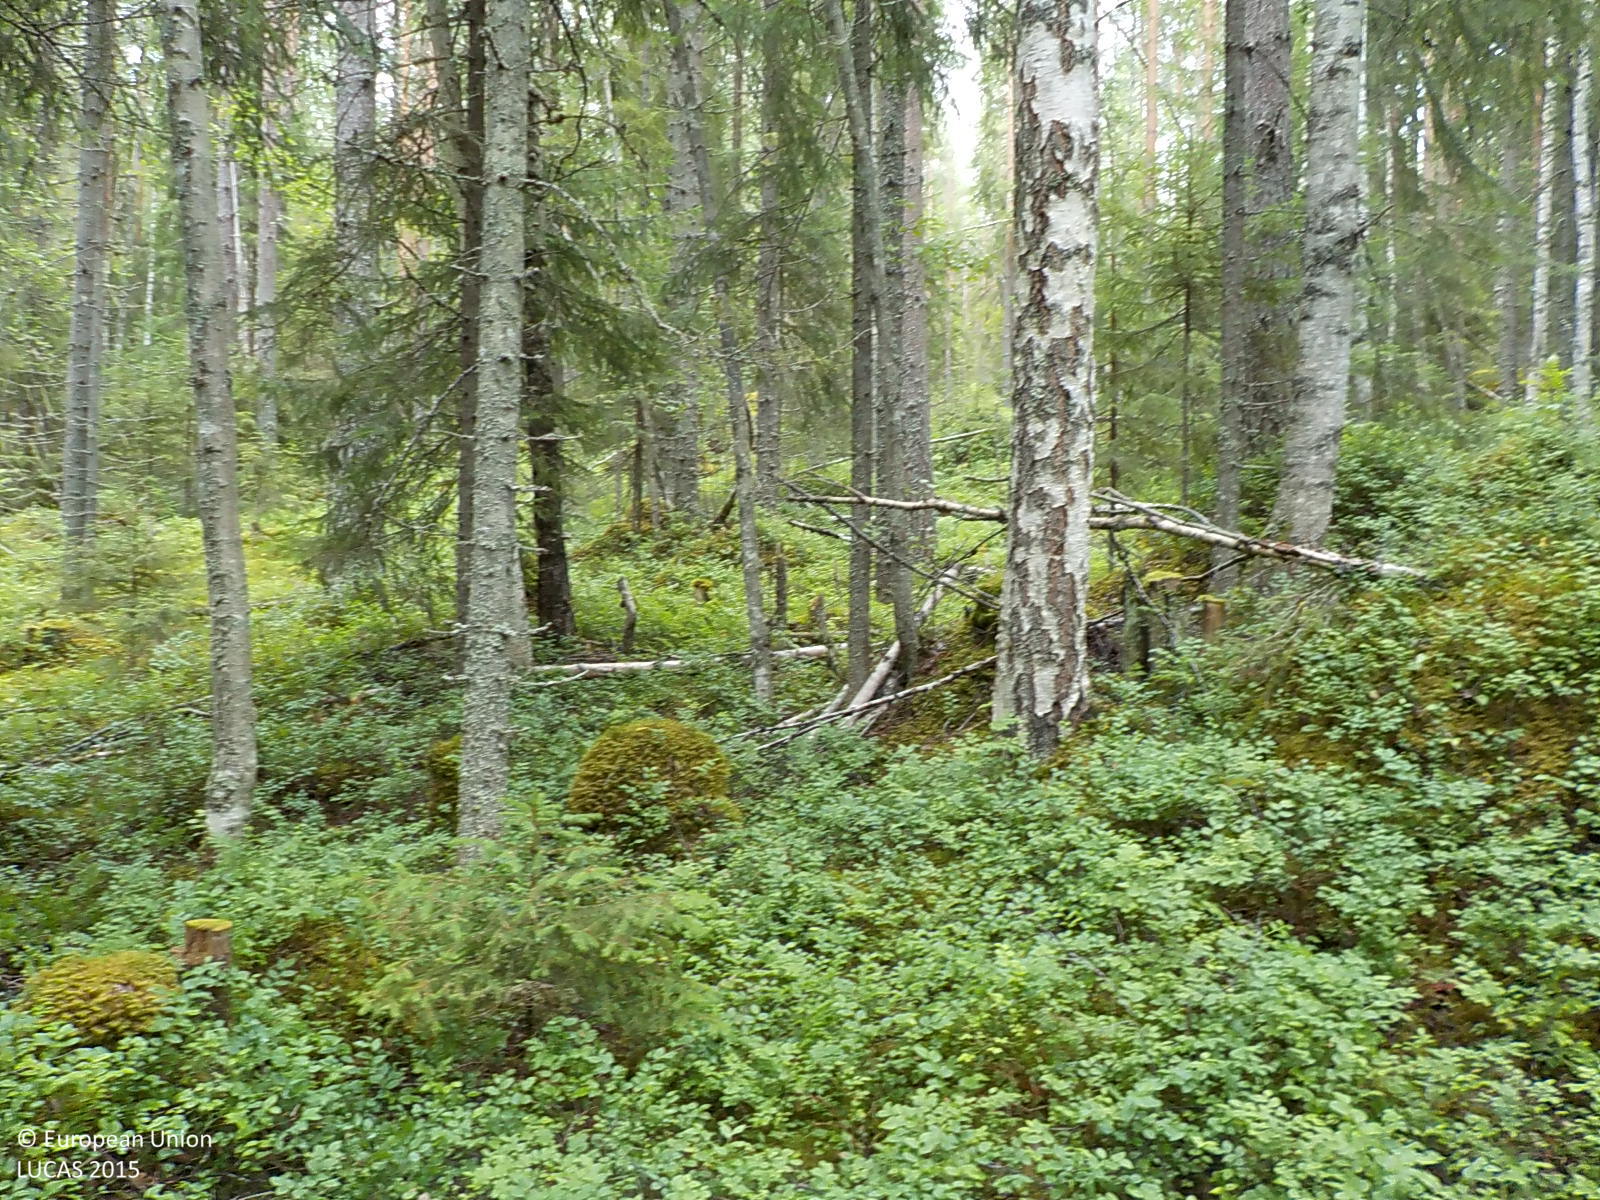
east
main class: Woodland
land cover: Spruce dominated coniferous woodland
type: boreal forest
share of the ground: 50 - 75 %
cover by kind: coniferous forest trees 60 %, shrubs 25 %, lichens and mosses 15 %
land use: Forestry
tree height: > 5 m
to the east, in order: Spruce dominated coniferous woodland; Pine dominated coniferous woodland
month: July
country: SE
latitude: 63.3090
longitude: 17.2185
